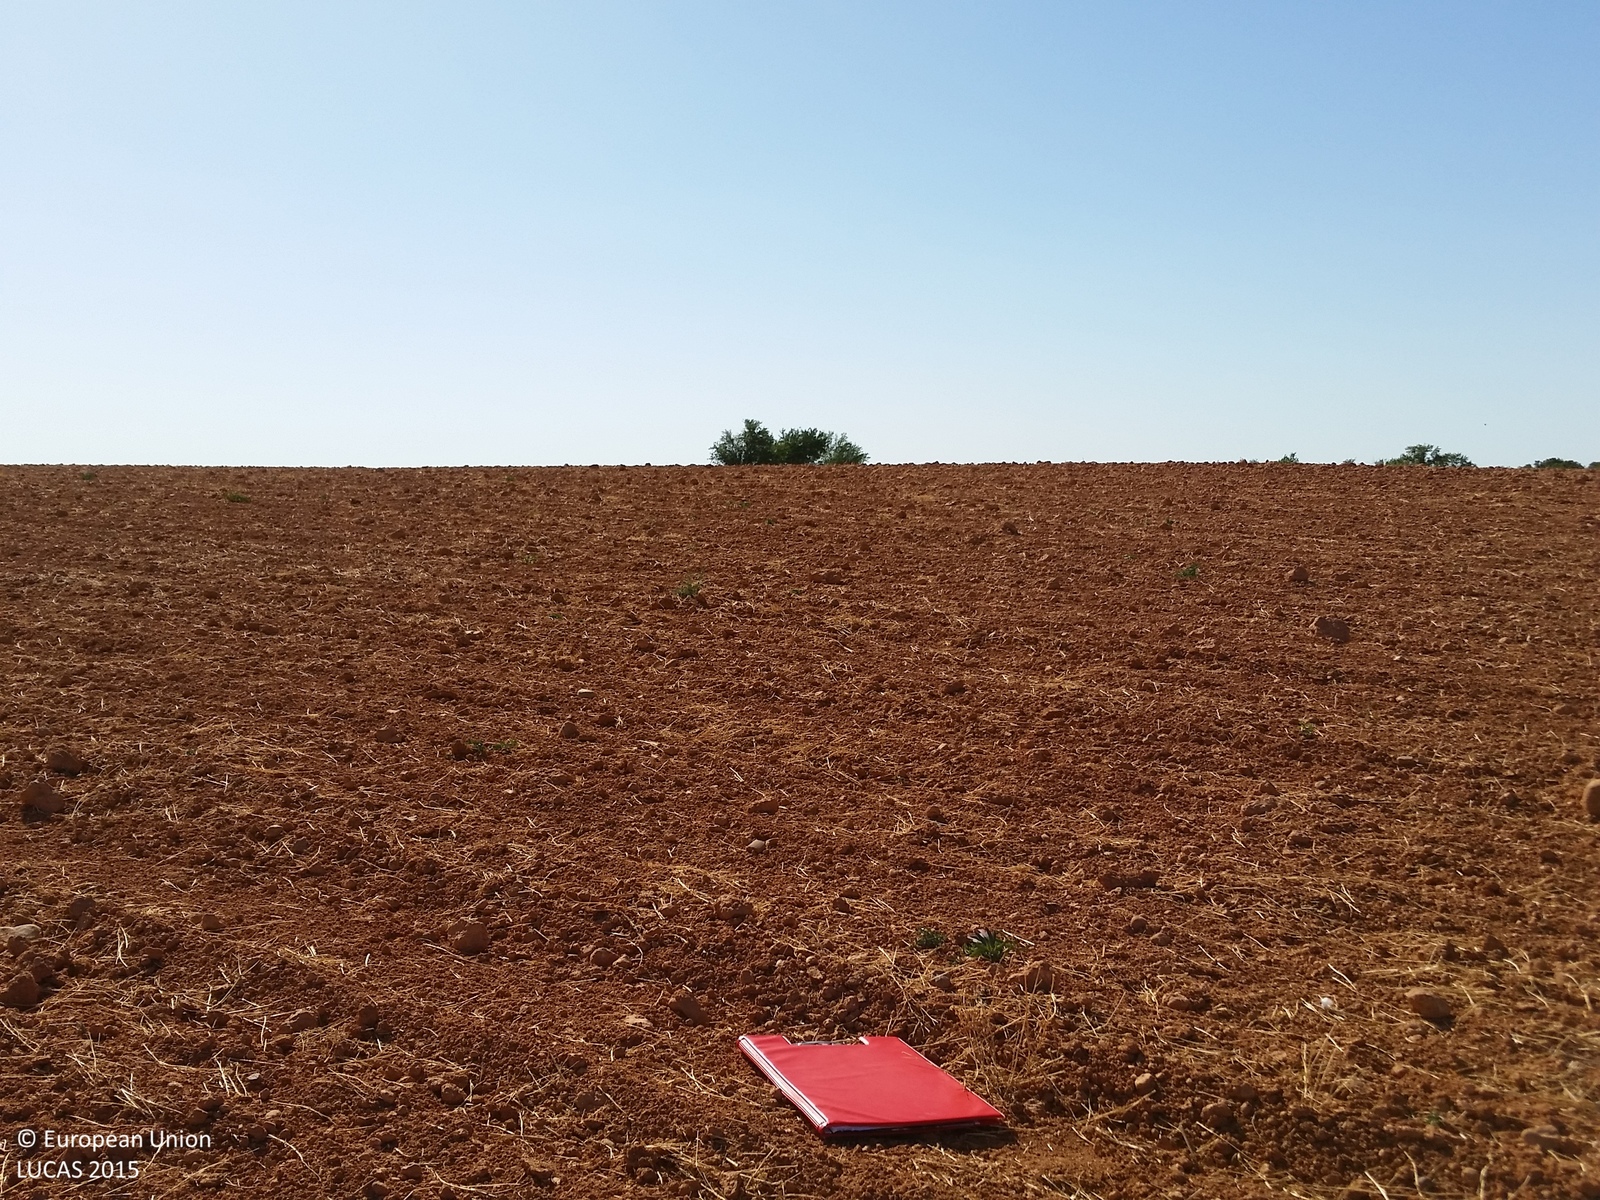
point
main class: Cropland
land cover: Other leguminous and mixtures for fodder
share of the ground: < 10 %
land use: Agriculture (excluding fallow land and kitchen gardens)
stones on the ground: 10 - 25 %
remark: Harvested field
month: July
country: ES
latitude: 39.2405
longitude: -2.6739
